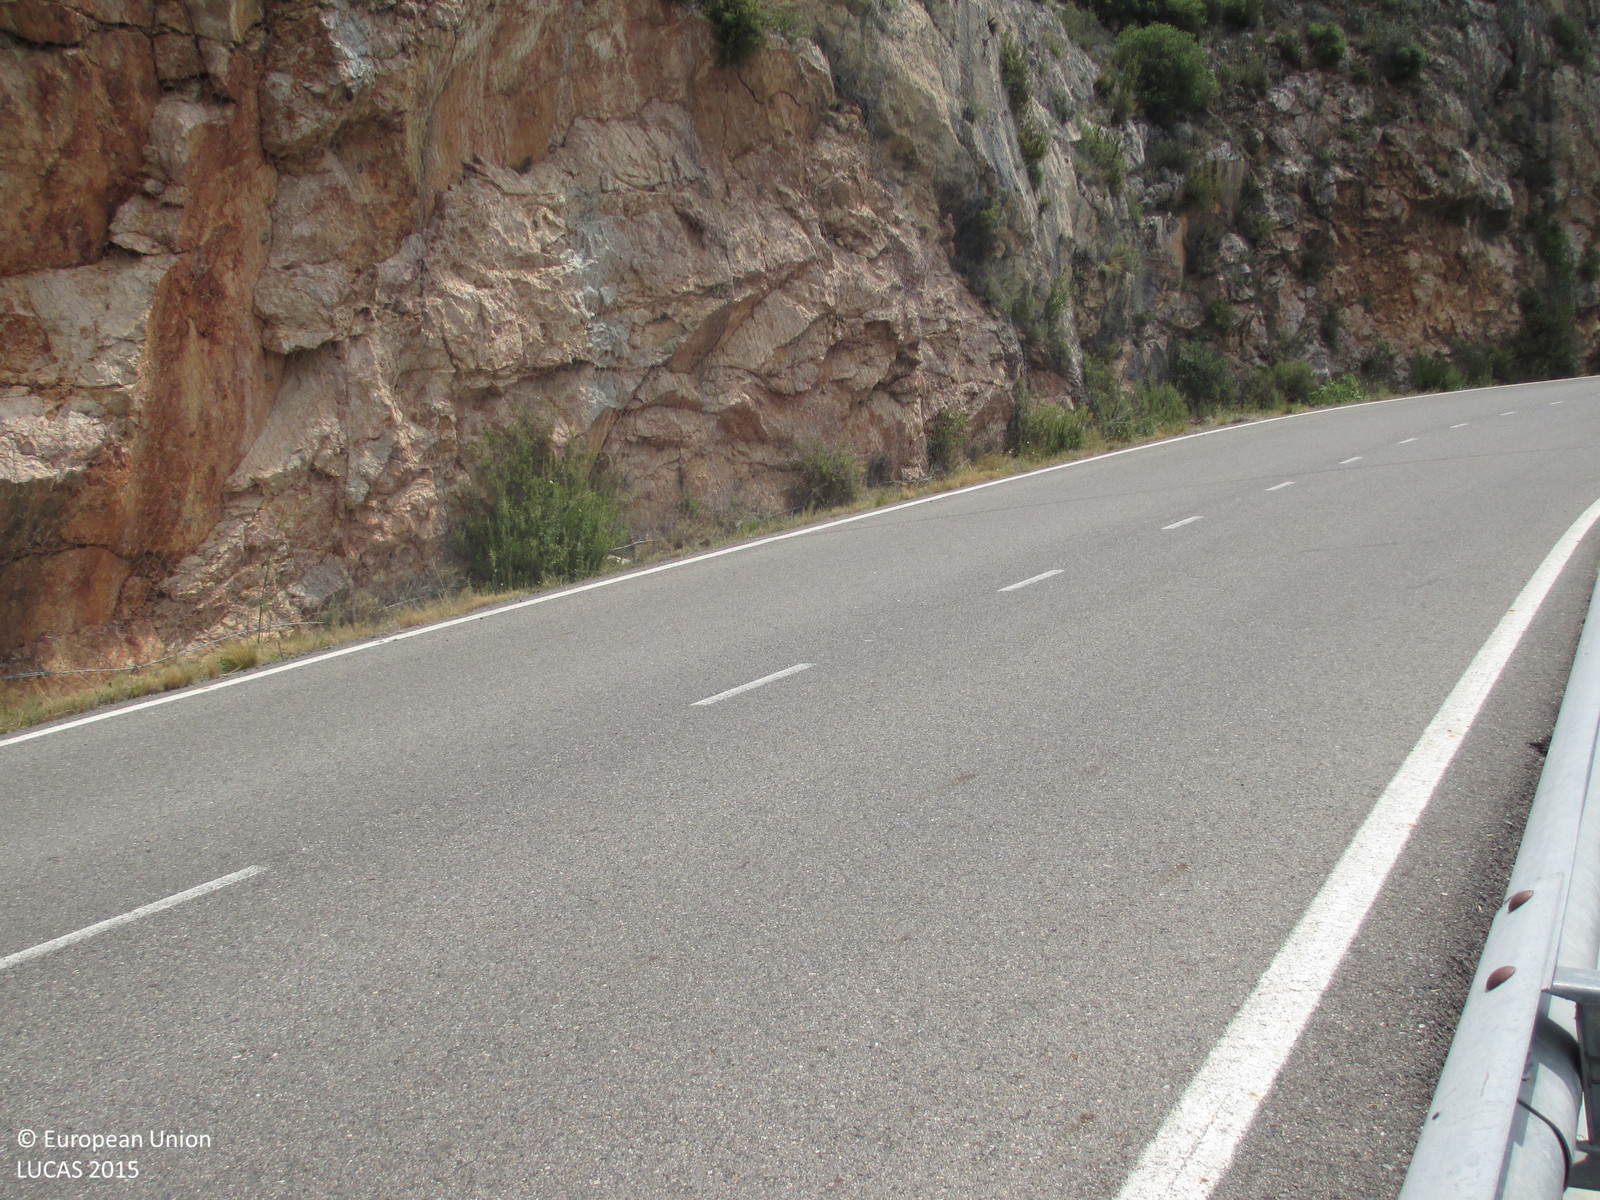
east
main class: Shrubland
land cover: Shrubland with sparse tree cover
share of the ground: > 75 %
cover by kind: shrubs 90 %, broadleaved forest trees 5 %, unconsolidated bare surface 5 %
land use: Semi-natural and natural areas not in use
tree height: < 5 m
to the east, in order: Shrubland with sparse tree cover; Paved roads, cycling and walking lanes; Electric lines; Paved roads, cycling and walking lanes; Shrubland with sparse tree cover; Pine dominated mixed woodland; Shrubland with sparse tree cover; Electric lines; Shrubland with sparse tree cover; Pine dominated mixed woodland
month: July
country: ES
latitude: 42.1632
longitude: 0.2378
